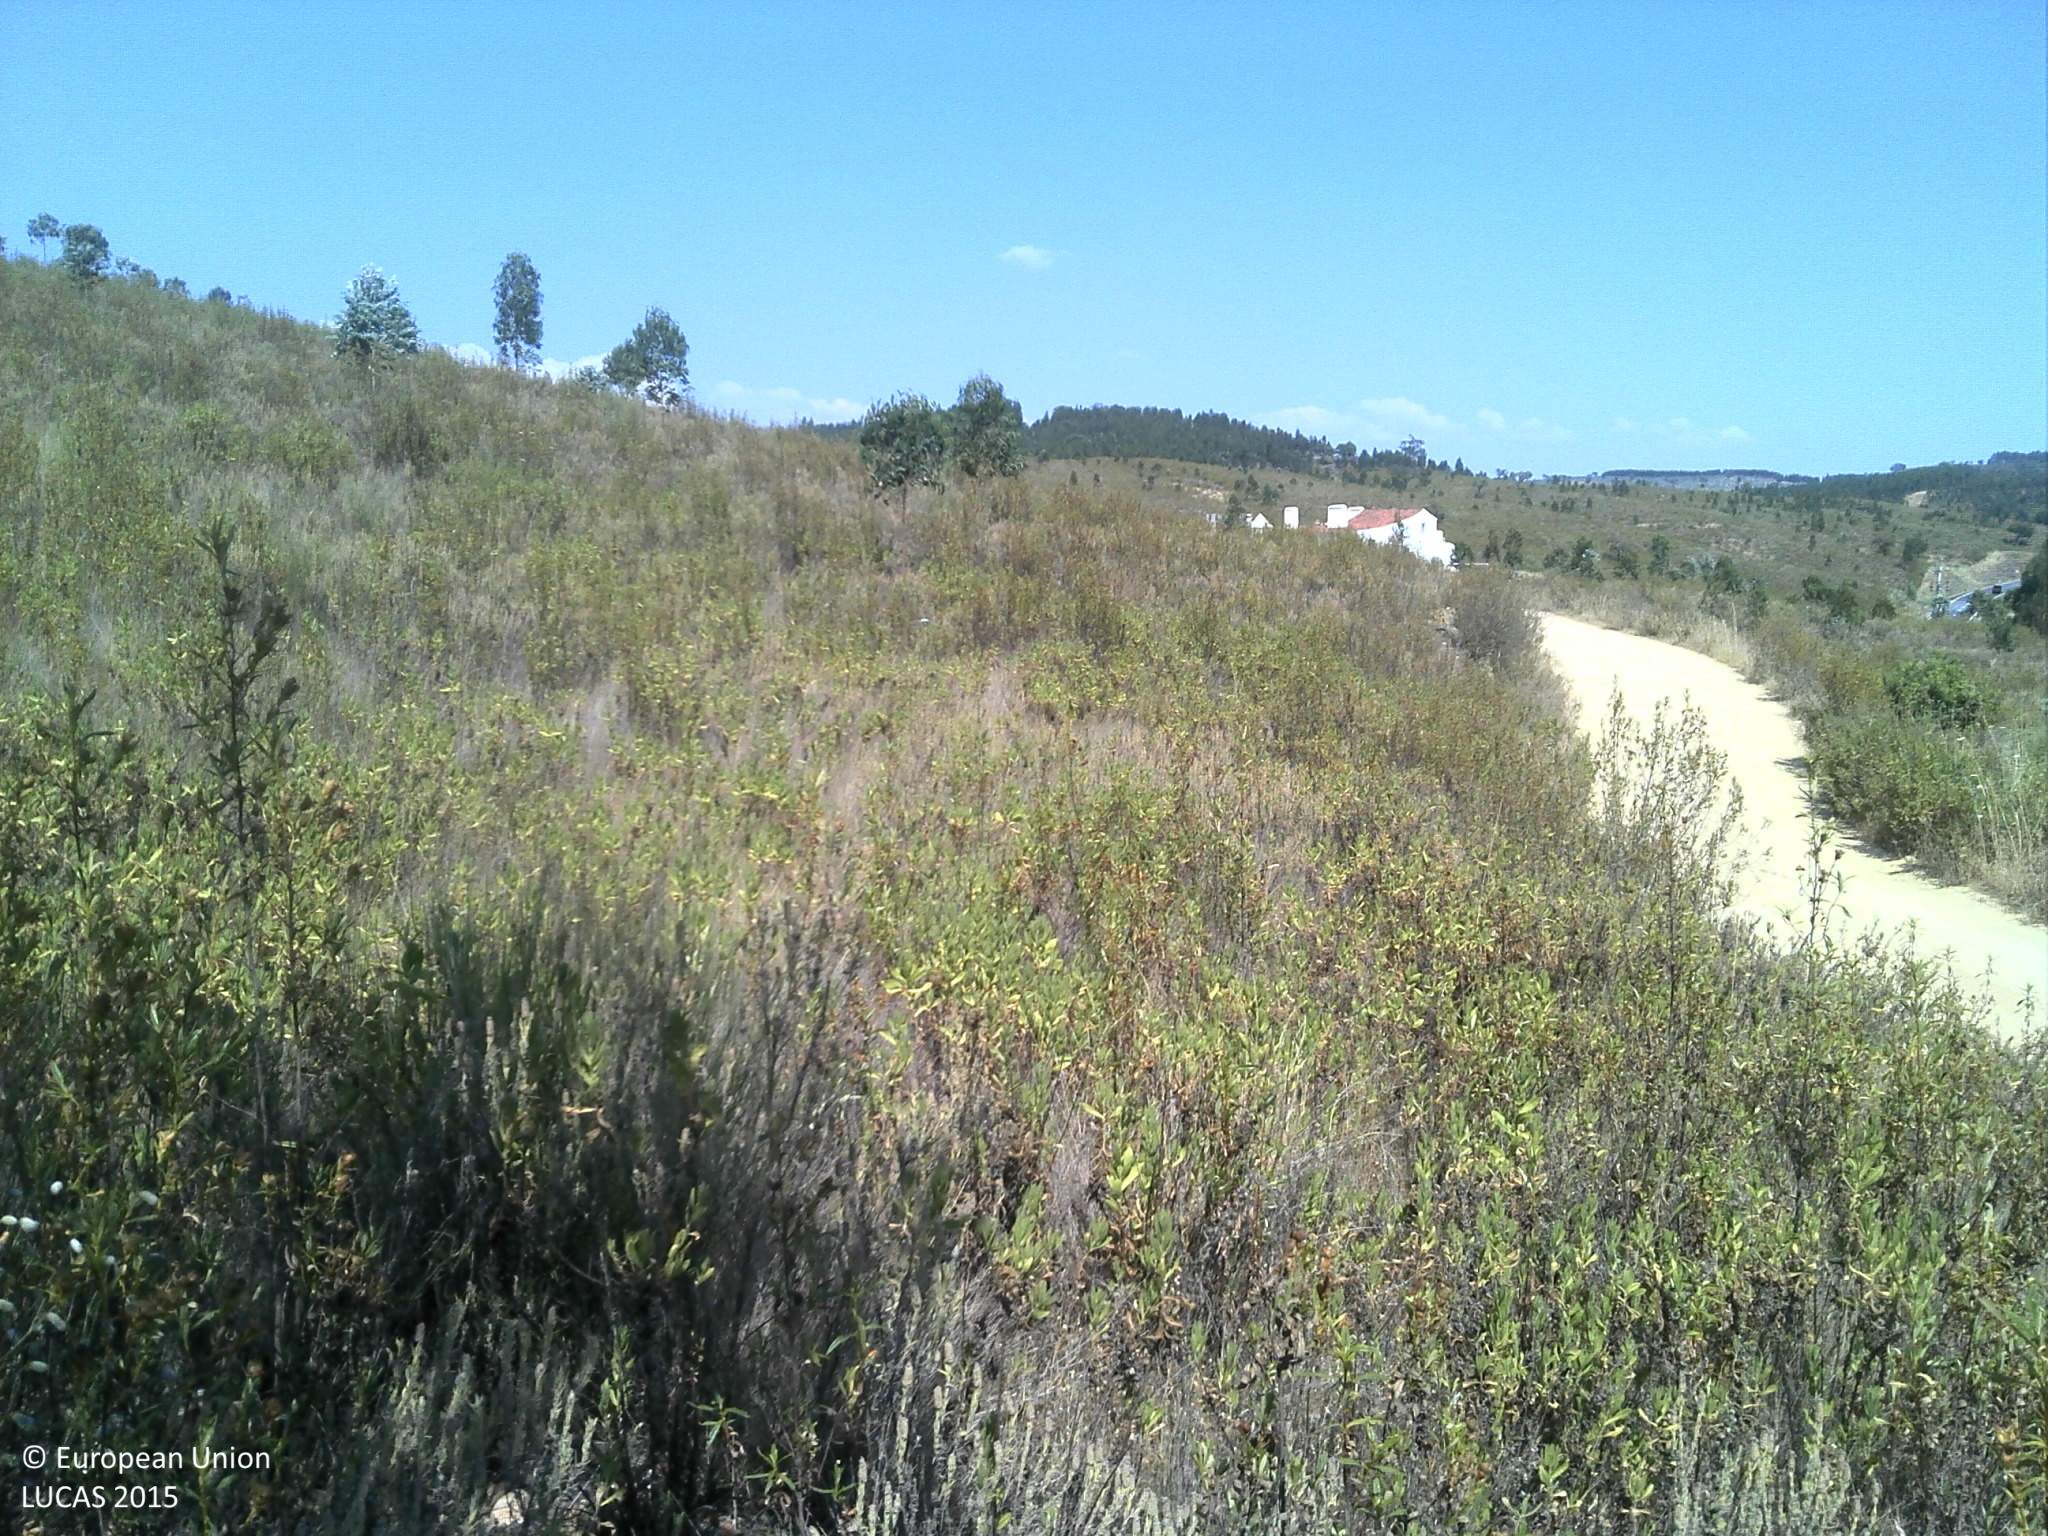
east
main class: Woodland
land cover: Broadleaved woodland
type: exotic forest
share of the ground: 10 - 25 %
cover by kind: shrubs 50 %, broadleaved forest trees 25 %, unconsolidated bare surface 15 %, herbaceous plants 10 %
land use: Forestry
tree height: < 5 m
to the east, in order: Broadleaved woodland; Tracks; Shrubland without tree cover; Broadleaved woodland; Tracks; Grassland without tree/shrub cover; Rivers and streams; Grassland without tree/shrub cover; Tracks; Shrubland without tree cover; Artificial constructions in urban areas
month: June
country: PT
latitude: 39.4574
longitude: -7.9907
